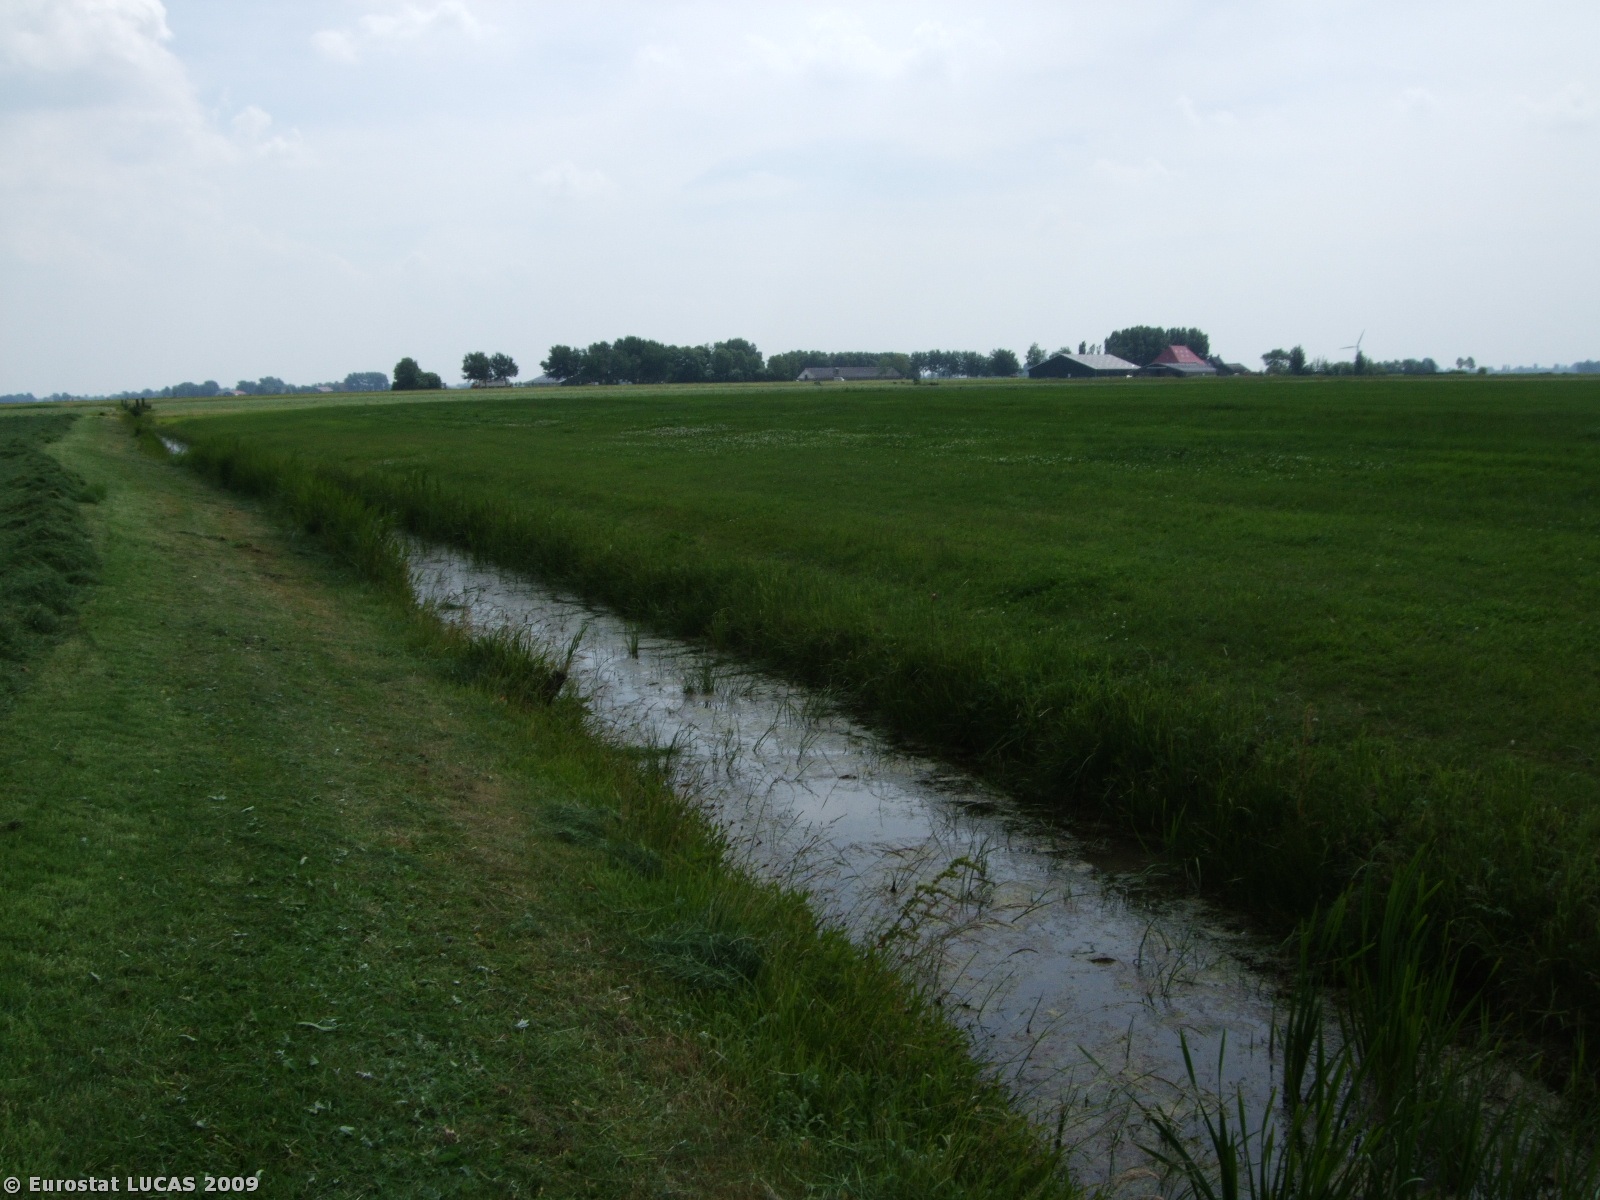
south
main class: Grassland
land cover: Grassland without tree/shrub cover
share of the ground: > 75 %
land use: Agriculture (excluding fallow land and kitchen gardens)
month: June
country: NL
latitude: 53.1427
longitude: 5.6186
